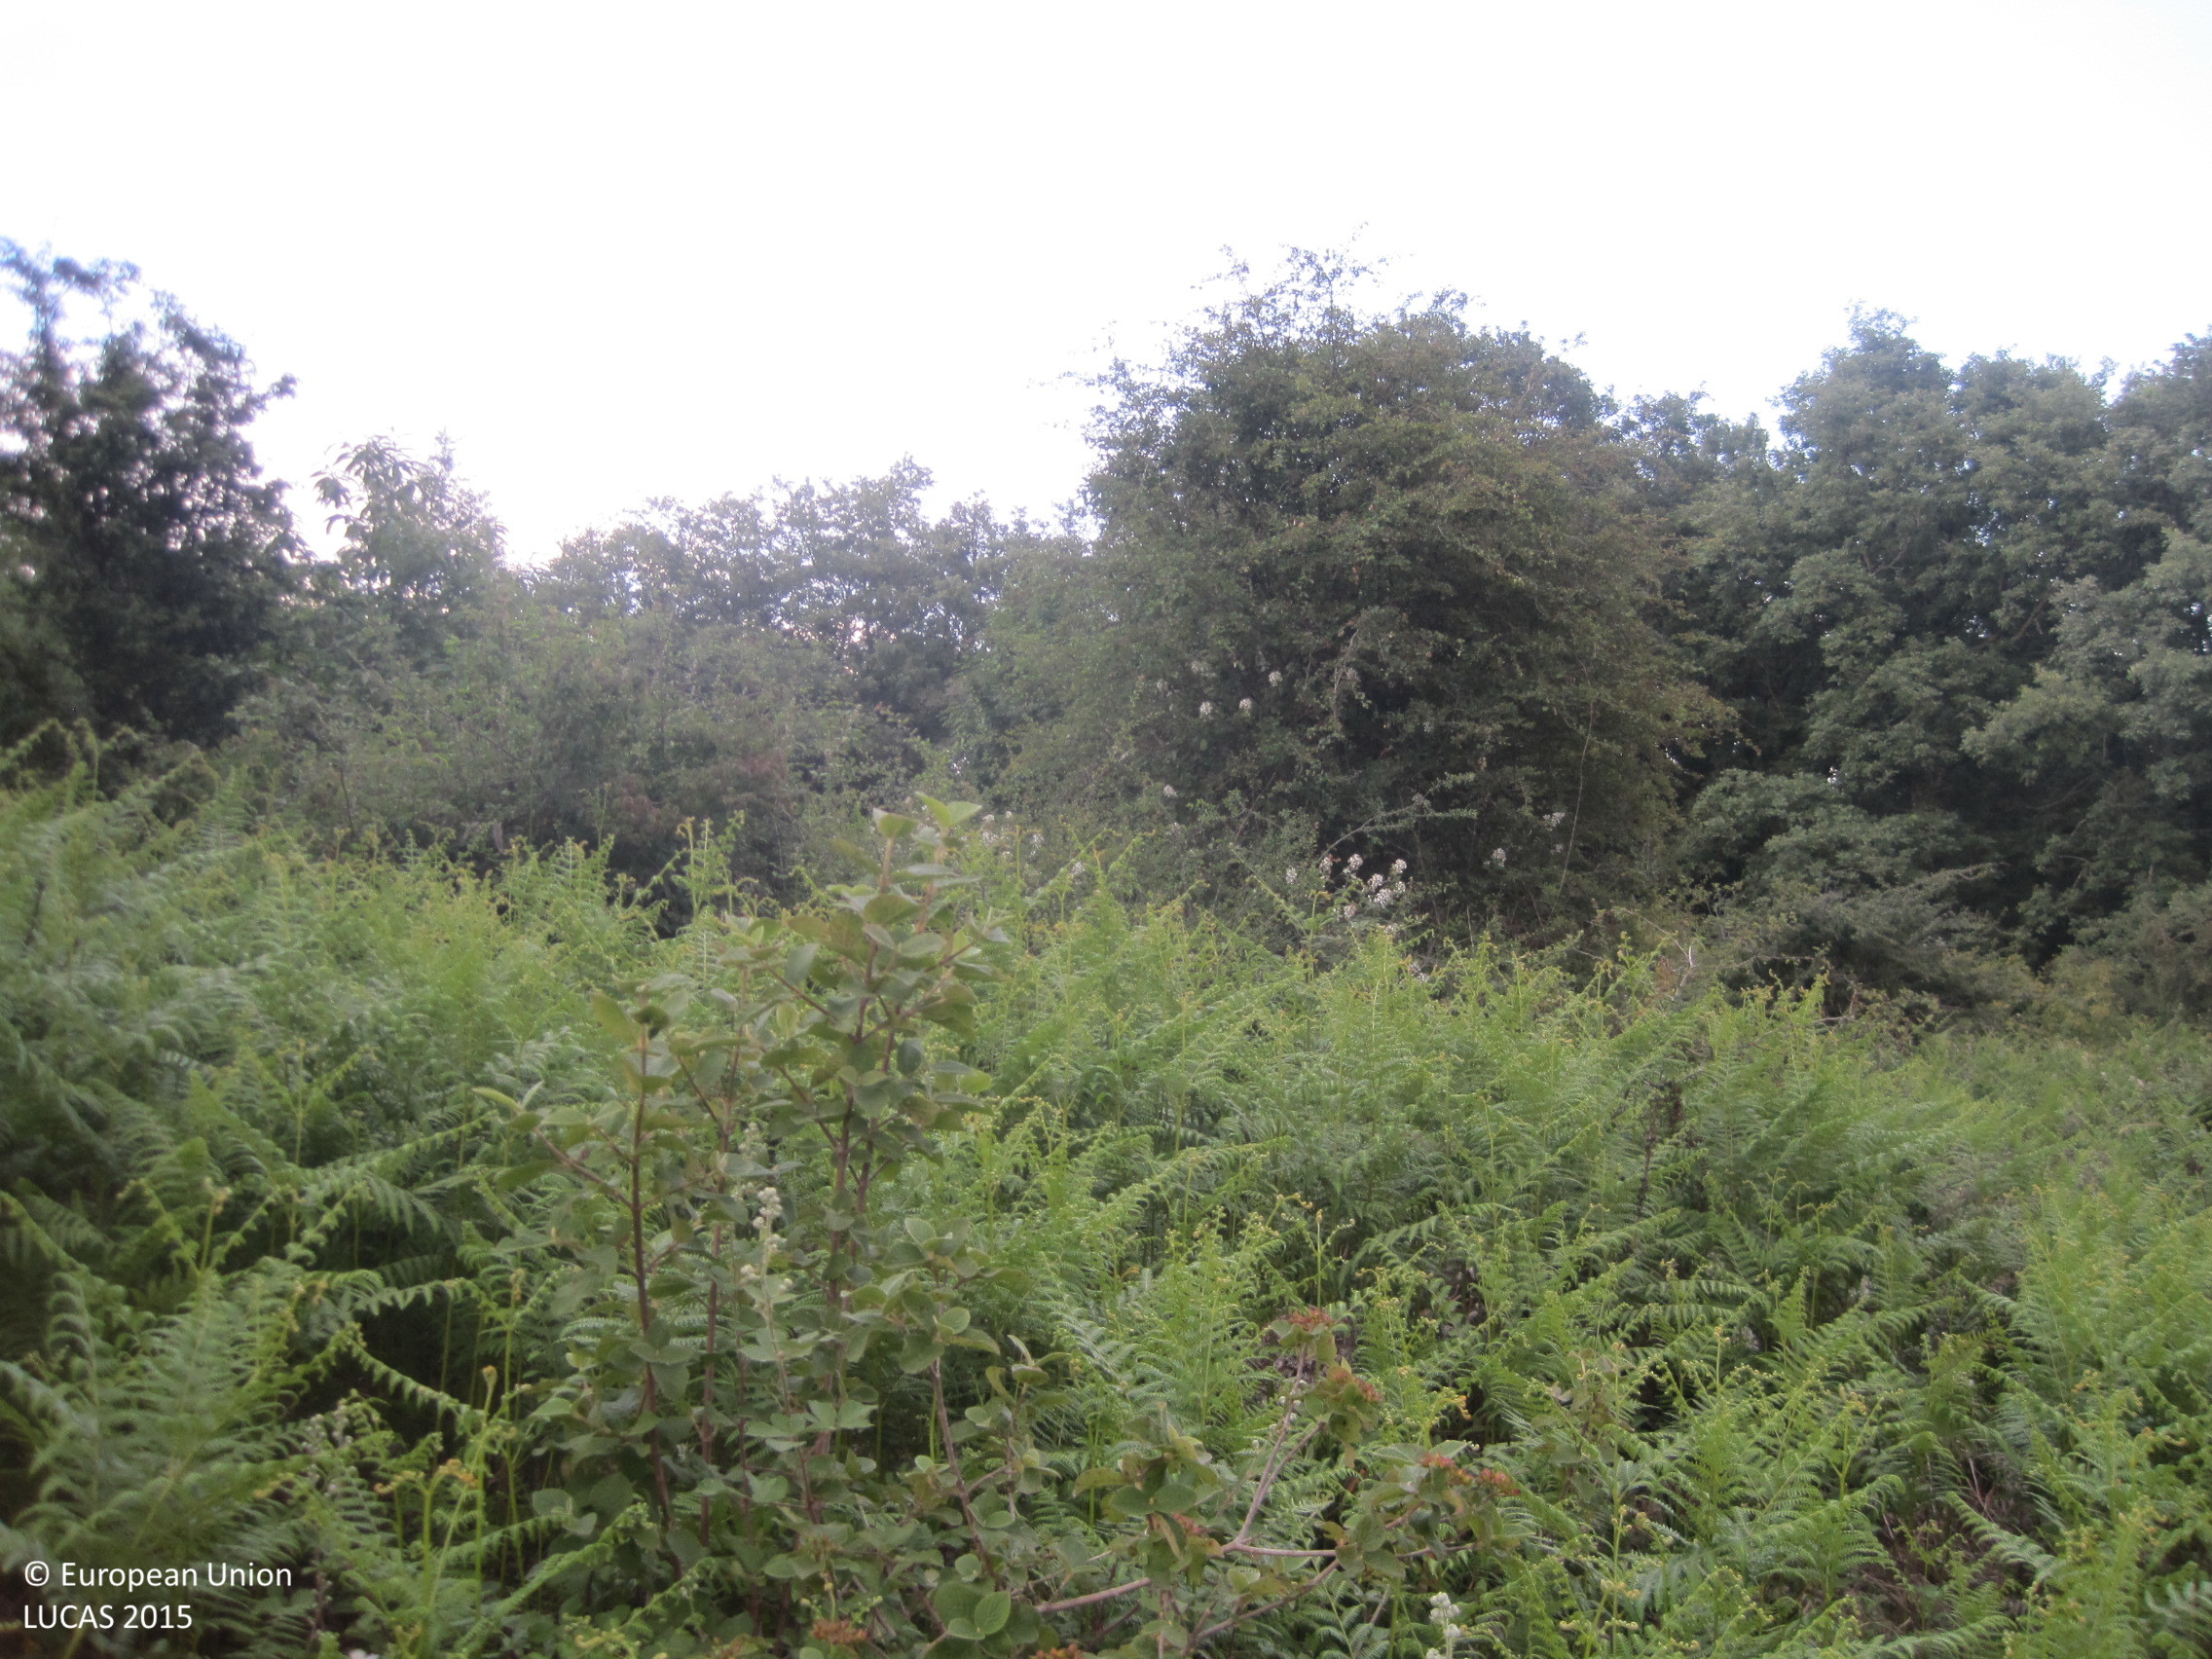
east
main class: Shrubland
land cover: Shrubland without tree cover
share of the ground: 10 - 25 %
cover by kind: herbaceous plants 80 %, shrubs 20 %
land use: Semi-natural and natural areas not in use
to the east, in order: Shrubland without tree cover; Broadleaved woodland; Shrubland with sparse tree cover; Broadleaved woodland; Tracks; Broadleaved woodland; Tracks; Broadleaved woodland; Dry stone walls; Maize
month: June
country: ES
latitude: 42.9728
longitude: -1.7264
